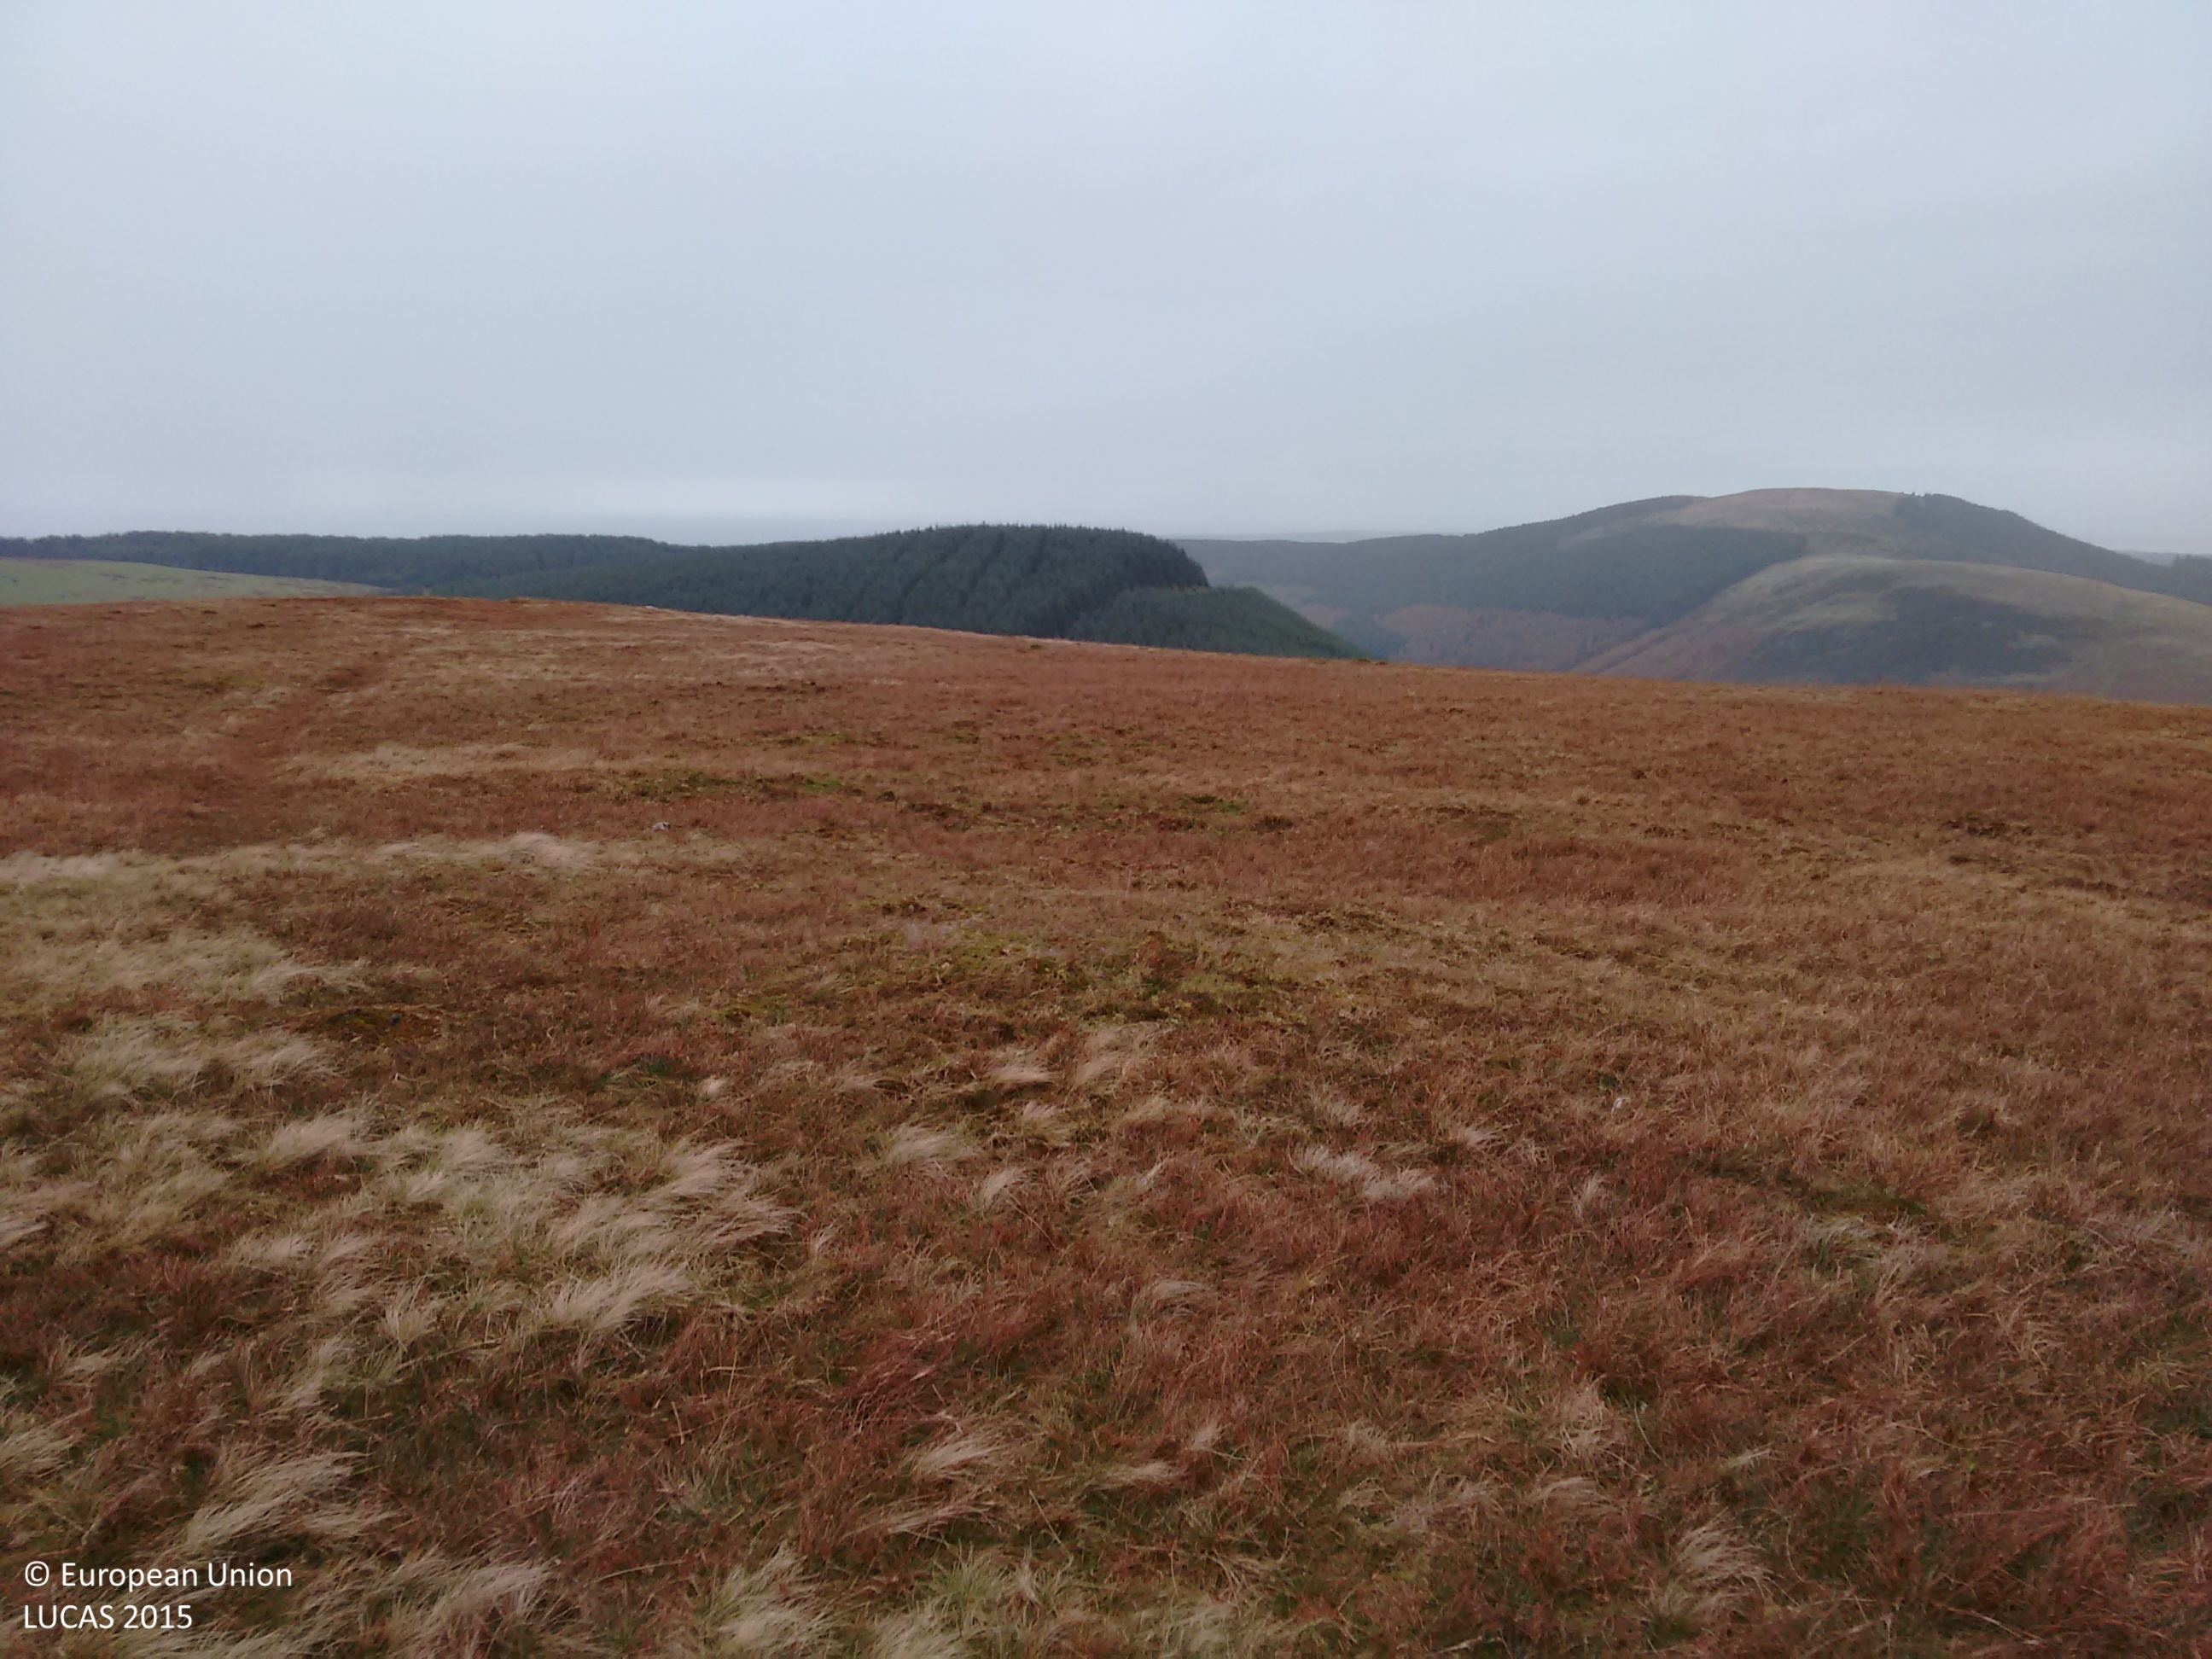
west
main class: Grassland
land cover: Grassland without tree/shrub cover
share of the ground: > 75 %
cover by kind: herbaceous plants 100 %
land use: Agriculture (excluding fallow land and kitchen gardens)
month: November
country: GB
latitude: 54.4914
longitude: -3.4346
